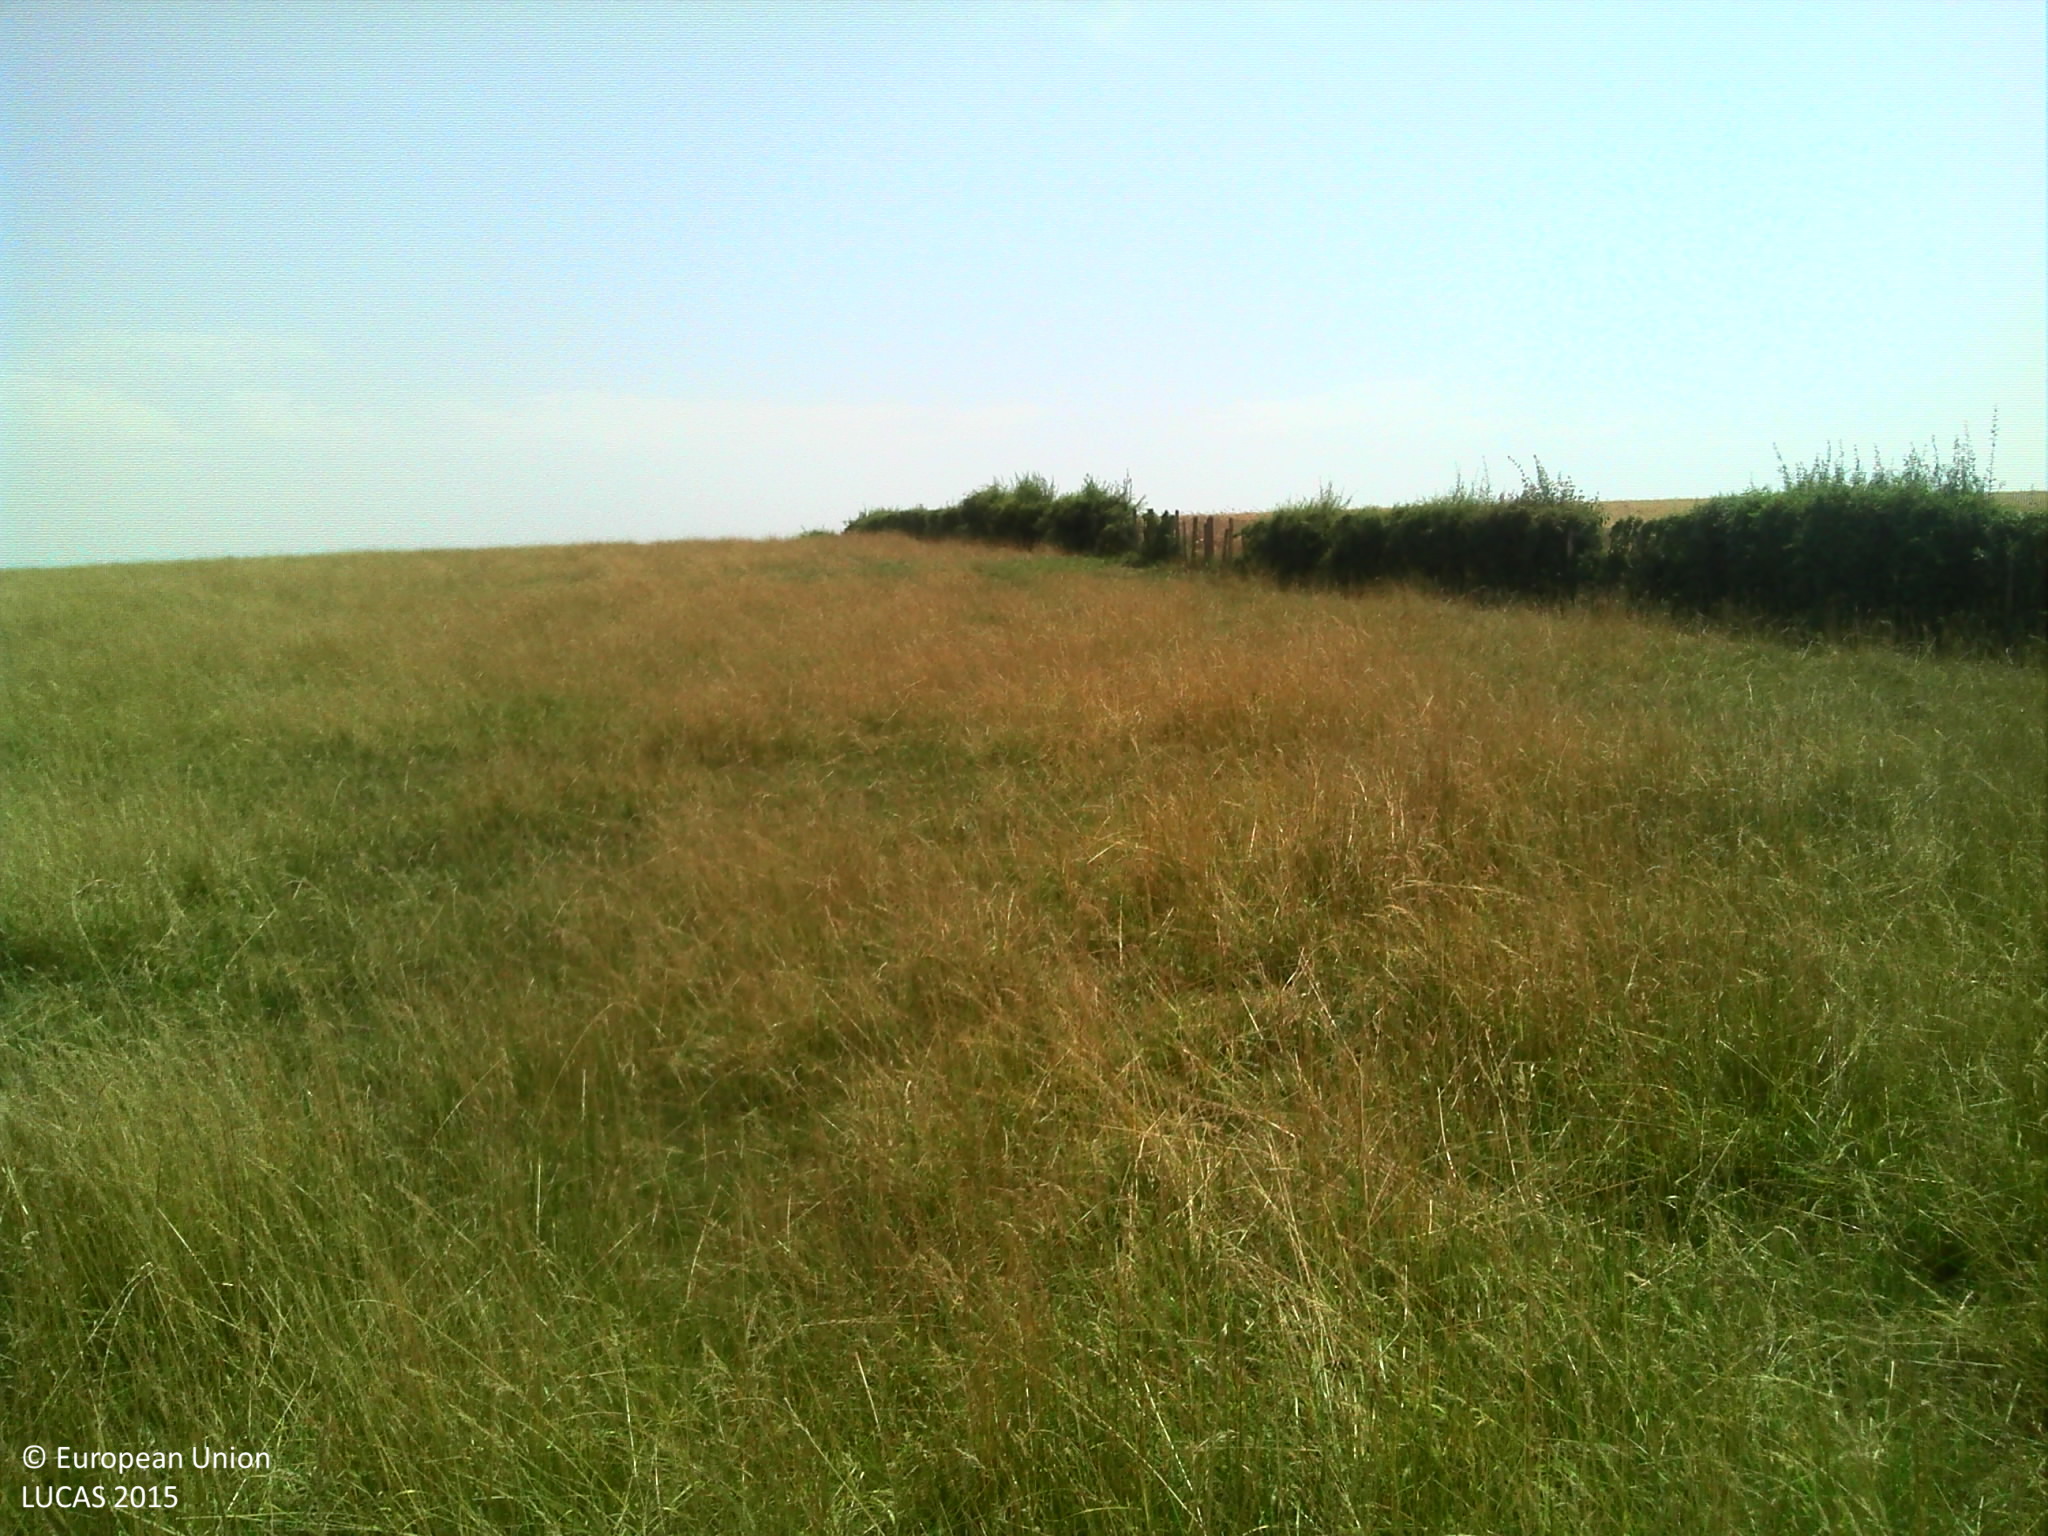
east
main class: Grassland
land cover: Grassland without tree/shrub cover
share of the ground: > 75 %
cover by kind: herbaceous plants 100 %
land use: Agriculture (excluding fallow land and kitchen gardens)
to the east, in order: Grassland without tree/shrub cover; Fences; Common wheat; Fences; Grassland without tree/shrub cover; Fences; Common wheat
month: July
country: FR
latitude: 46.8969
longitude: 5.2894
